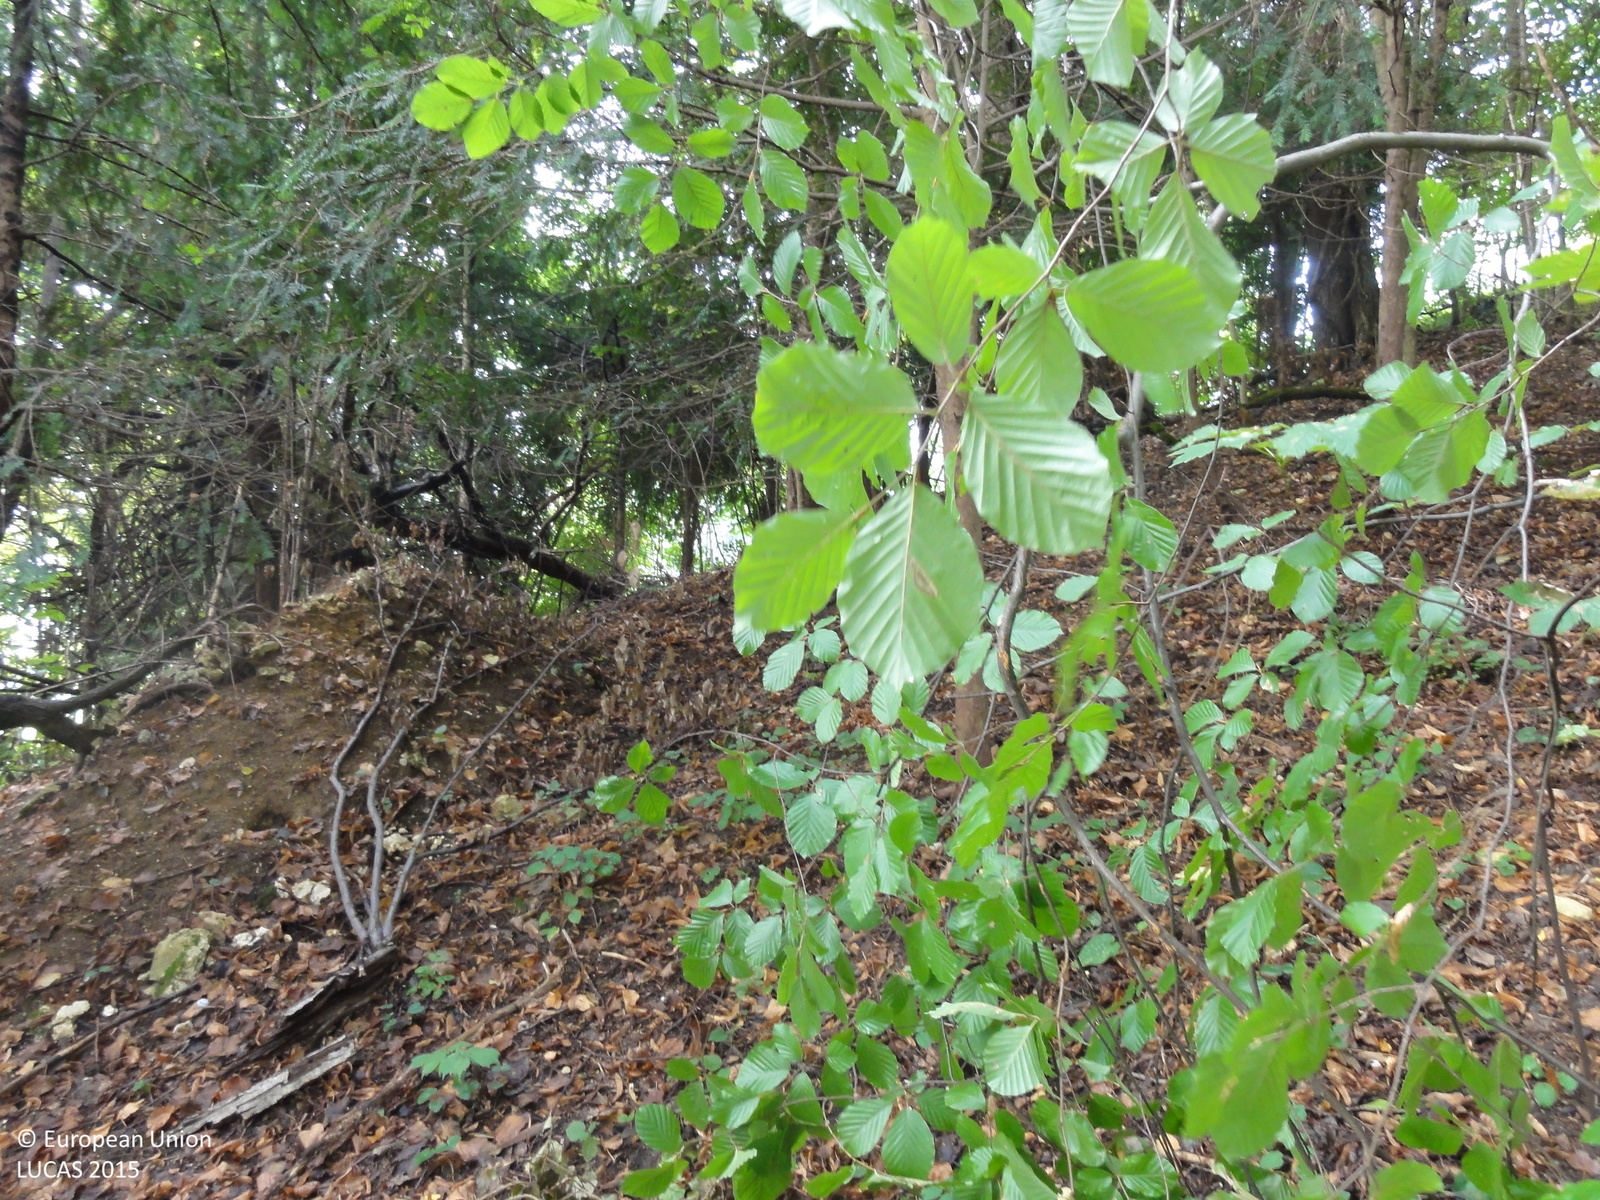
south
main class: Woodland
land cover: Spruce dominated mixed woodland
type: mountainous beech forest
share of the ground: > 75 %
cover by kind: coniferous forest trees 50 %, broadleaved forest trees 50 %
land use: Forestry
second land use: Sport
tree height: > 5 m
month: September
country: SI
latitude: 45.8574
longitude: 15.6772
